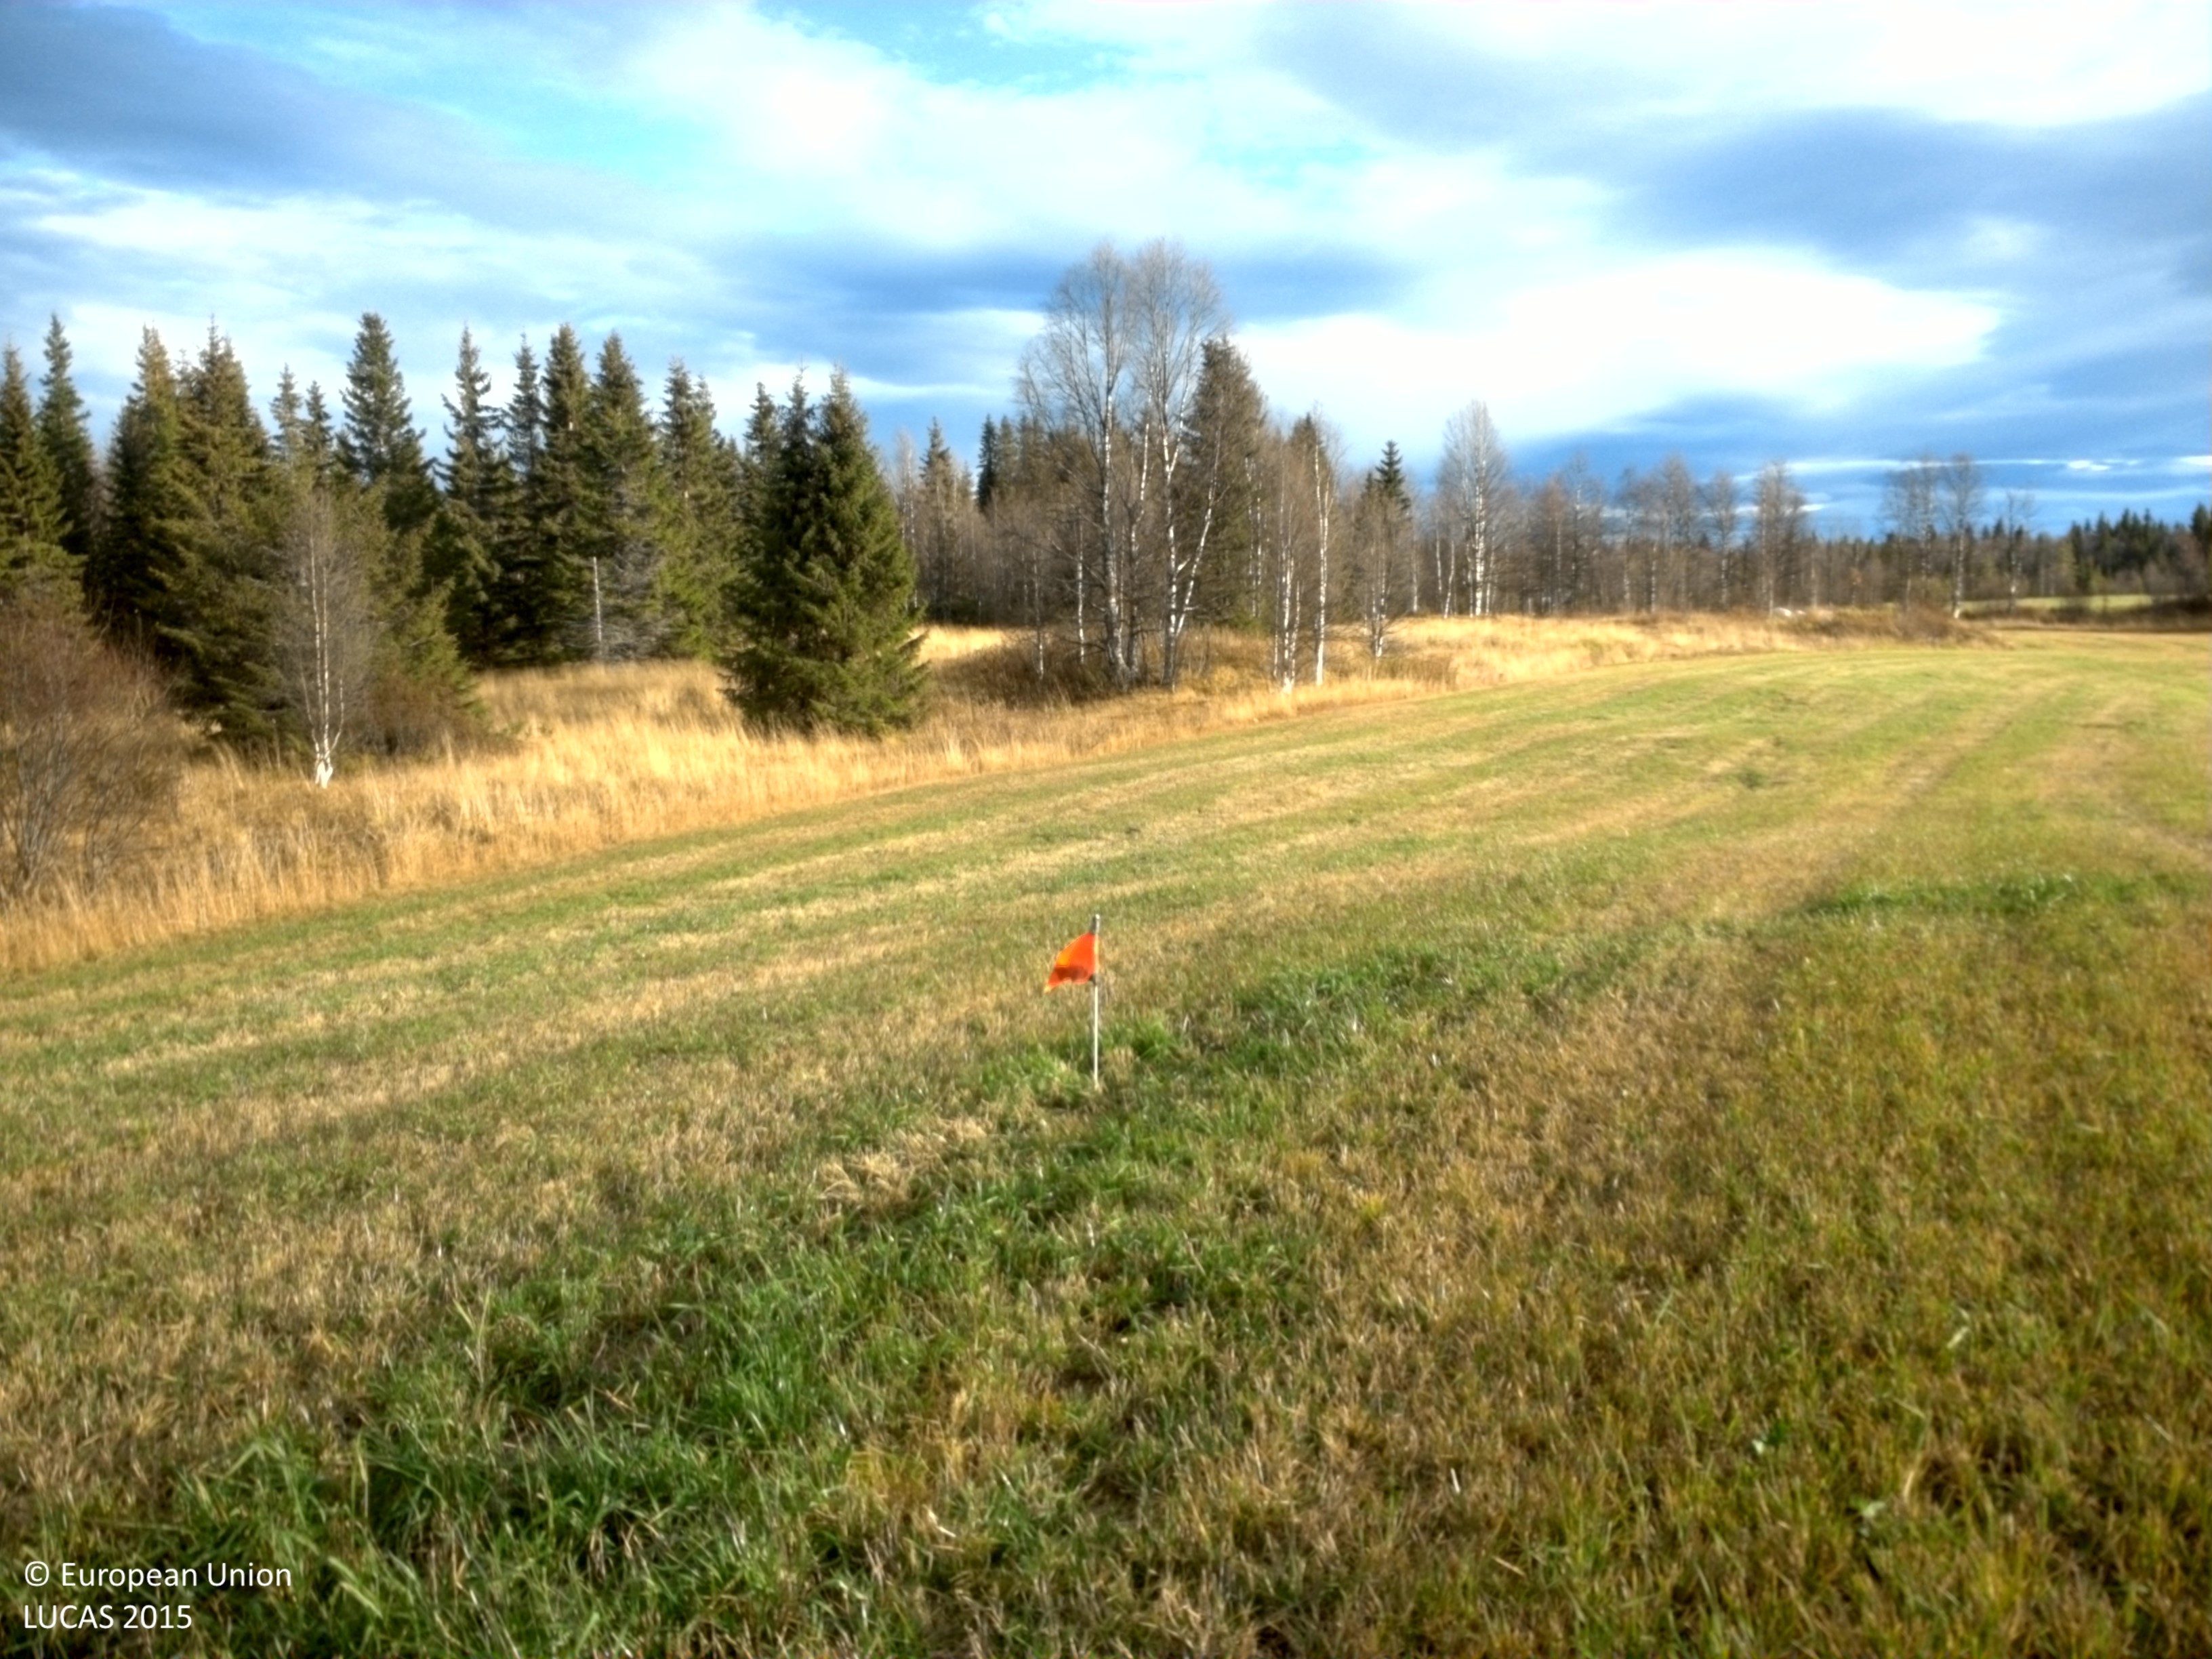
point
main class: Grassland
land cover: Grassland without tree/shrub cover
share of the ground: > 75 %
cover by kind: herbaceous plants 100 %
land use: Agriculture (excluding fallow land and kitchen gardens)
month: October
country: SE
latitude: 64.5405
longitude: 16.4102
